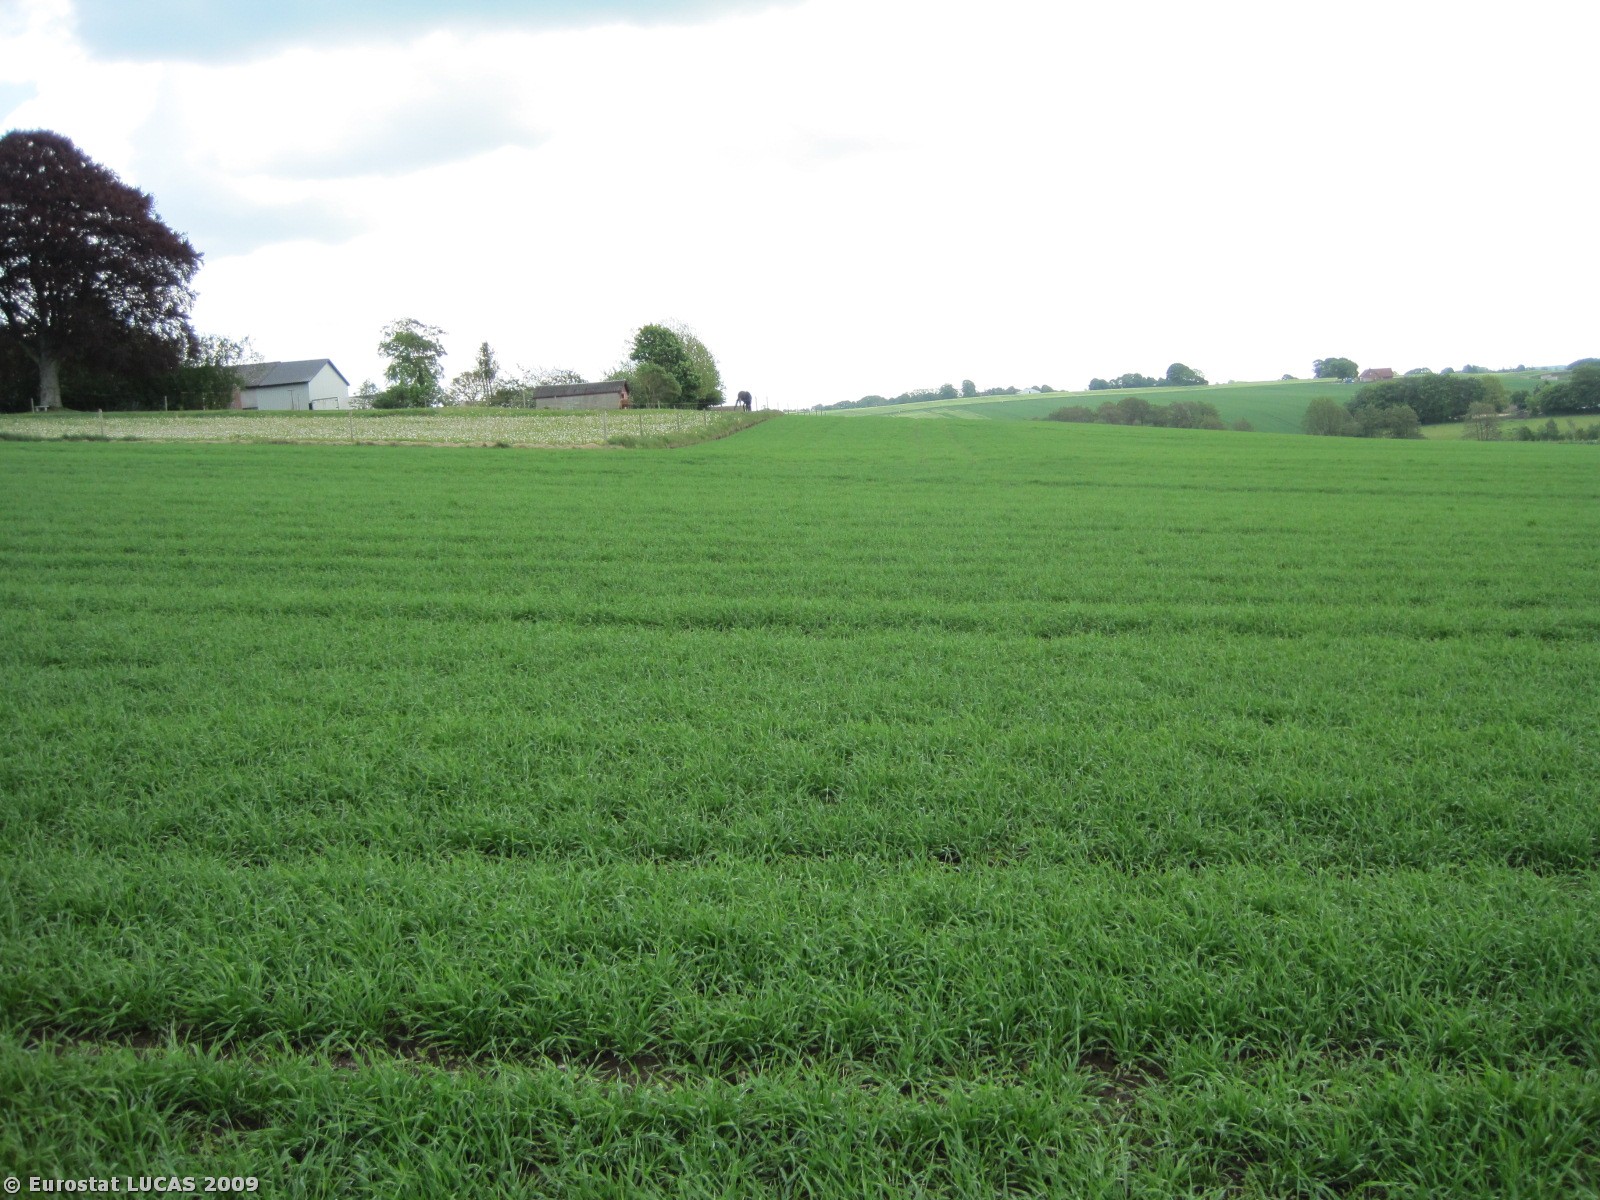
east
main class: Cropland
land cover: Barley
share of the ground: > 75 %
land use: Agriculture (excluding fallow land and kitchen gardens)
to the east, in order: Barley; Grass margins; Fences; Grassland without tree/shrub cover; Fences; Grass margins; Tracks; Grass margins; Common wheat; Grass margins; Common wheat
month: May
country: DK
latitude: 56.3493
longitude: 9.7576
